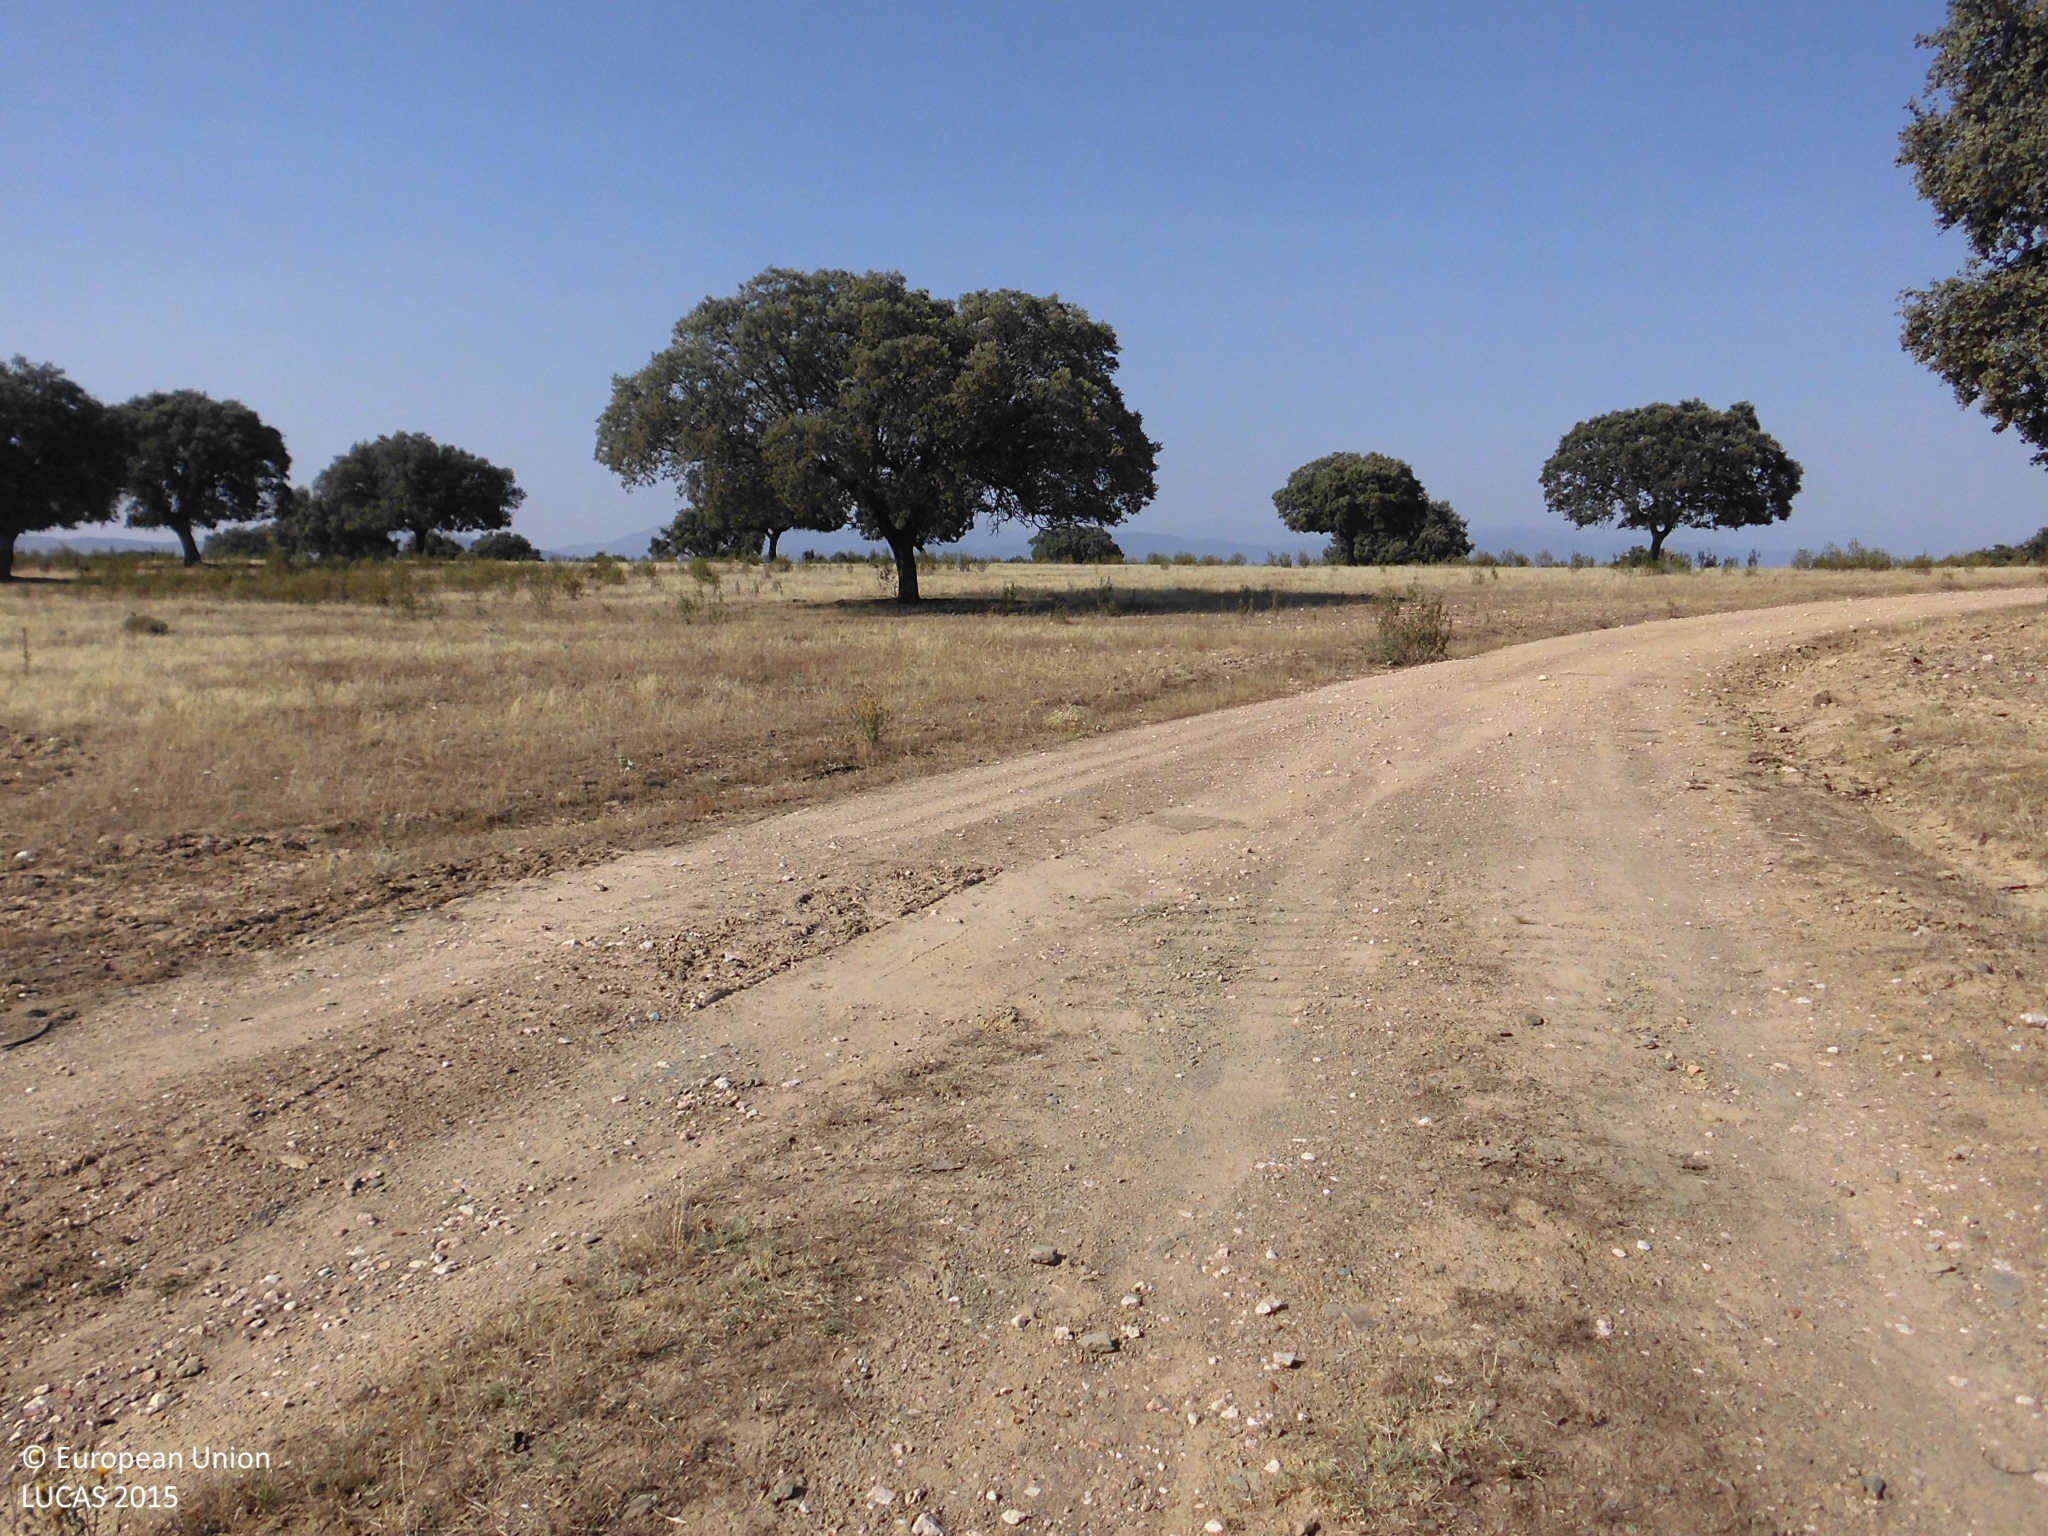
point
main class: Woodland
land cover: Broadleaved woodland
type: broadleaved evergreen forest
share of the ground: 25 - 50 %
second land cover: Shrubland without tree cover
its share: > 75 %
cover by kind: herbaceous plants 50 %, broadleaved forest trees 25 %, shrubs 25 %
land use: Forestry
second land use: Agriculture (excluding fallow land and kitchen gardens)
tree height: > 5 m
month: June
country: ES
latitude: 39.9314
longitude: -6.0416
